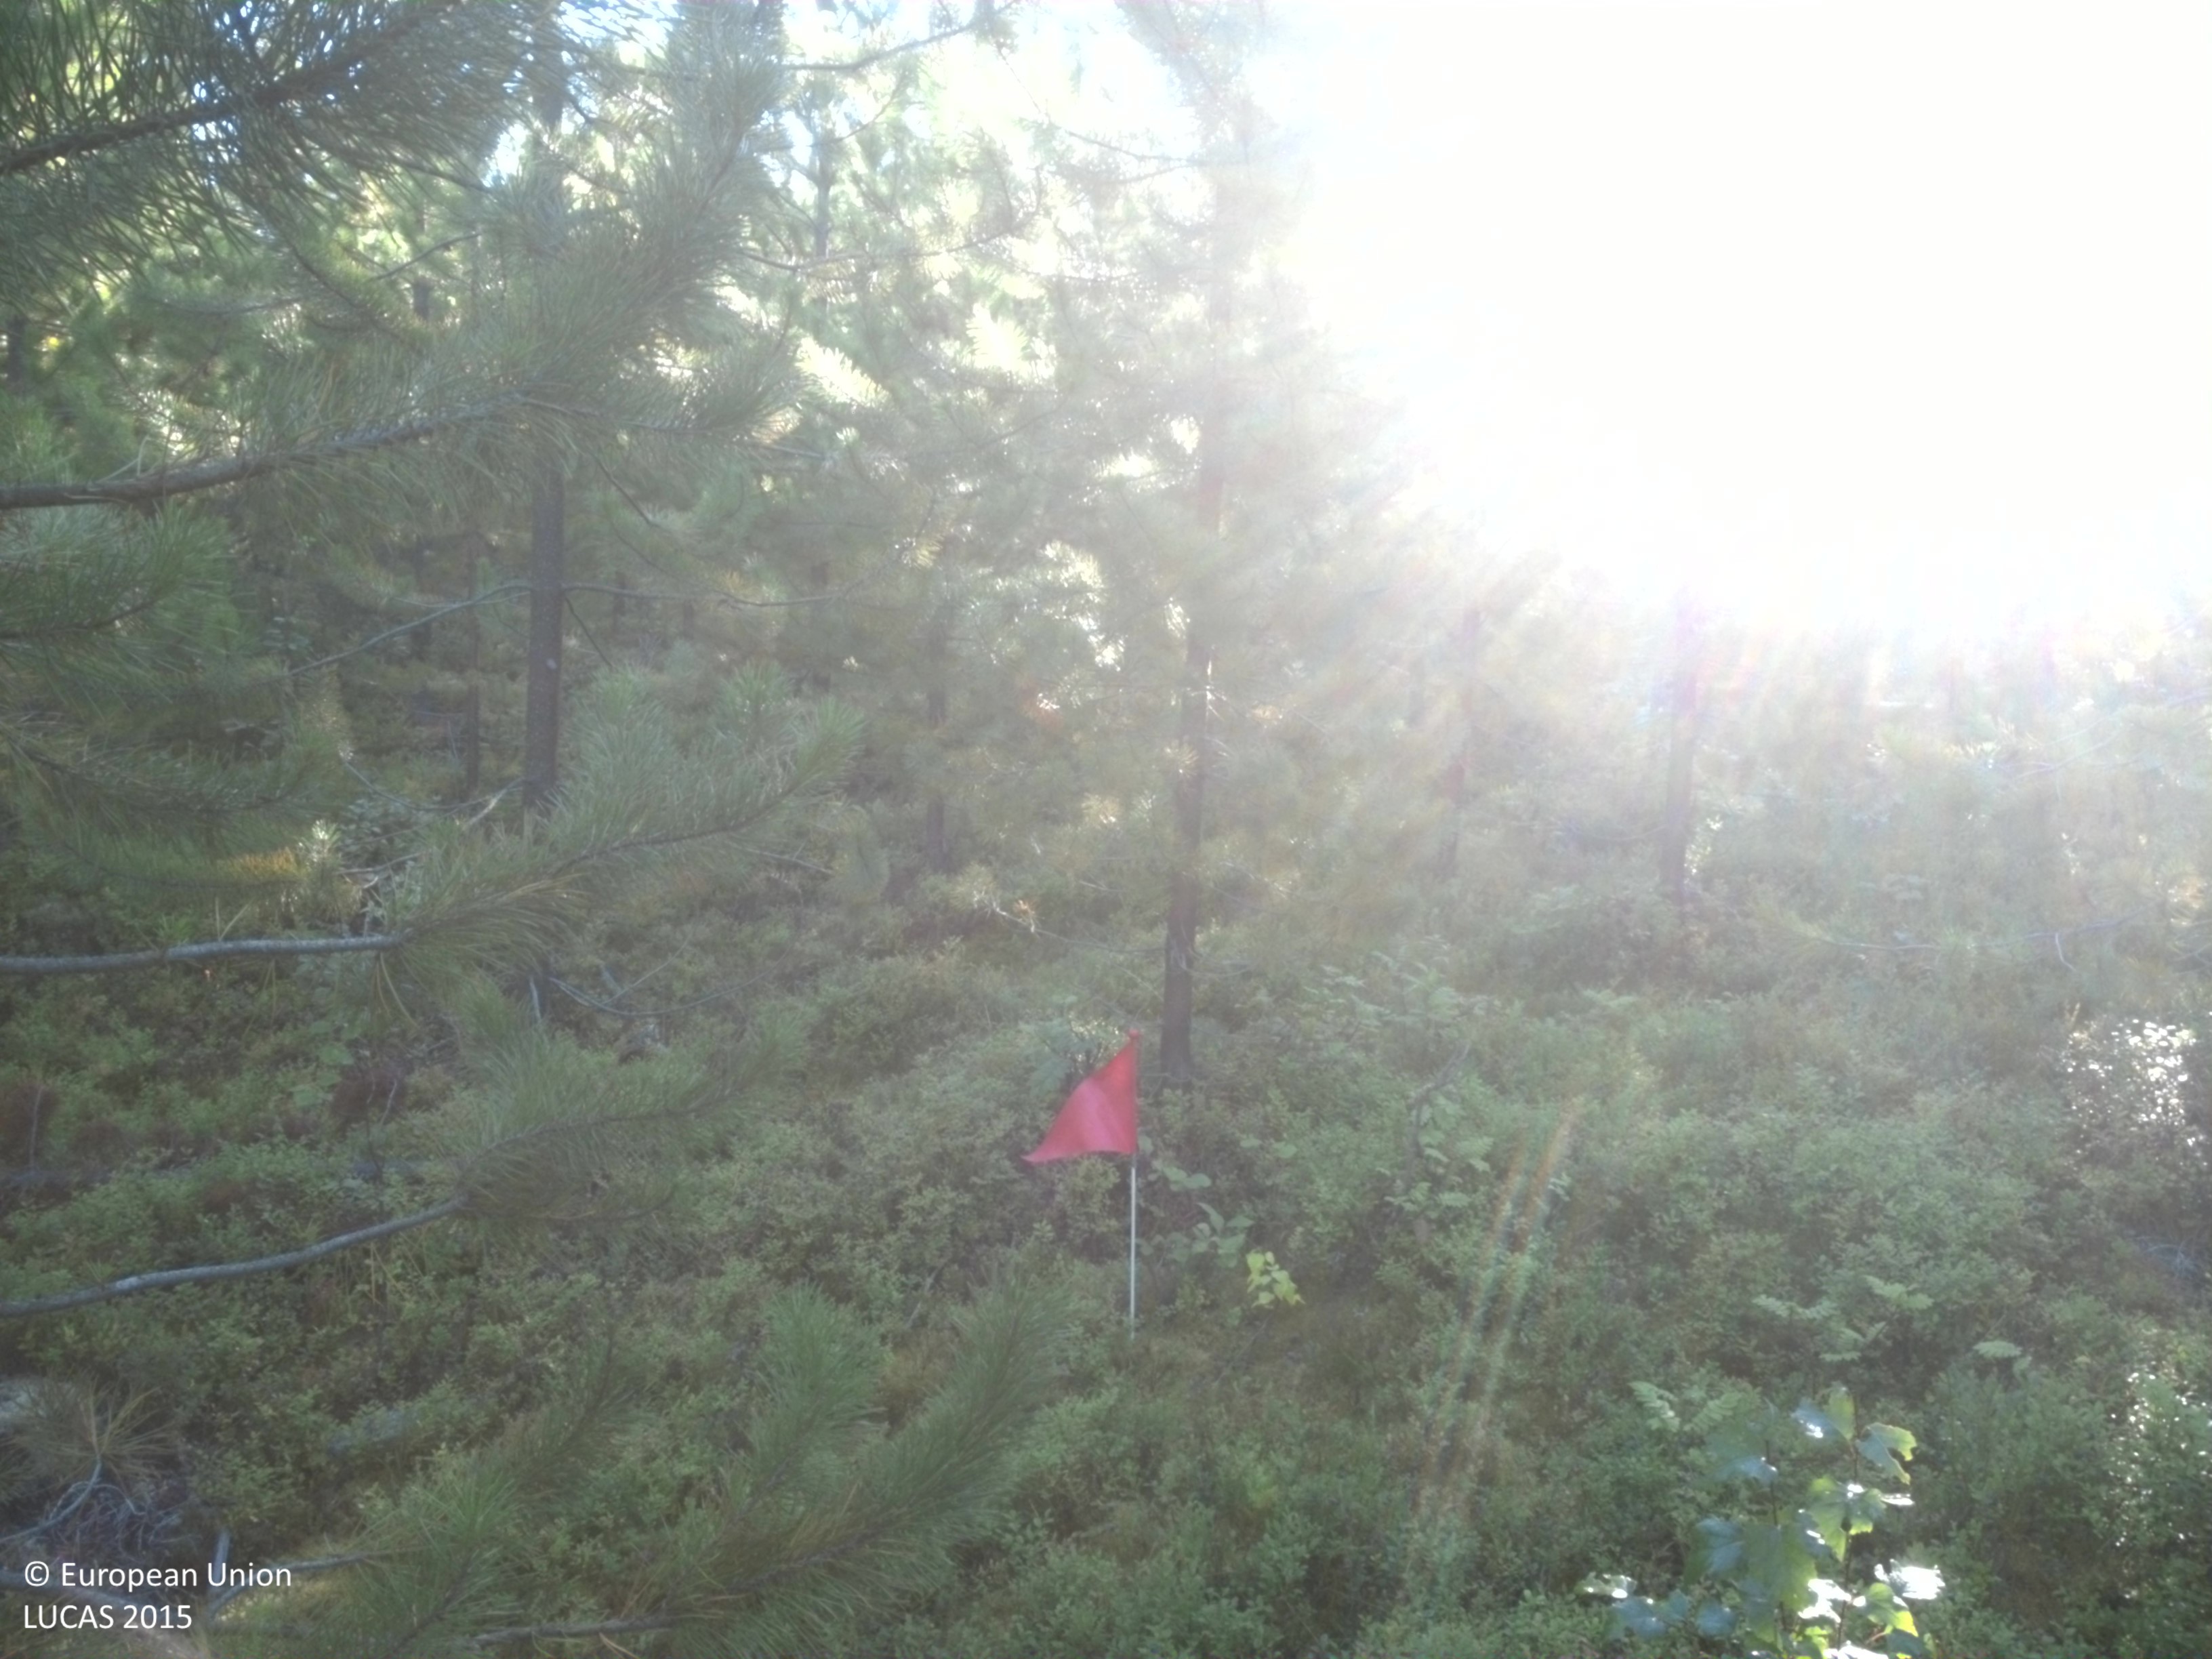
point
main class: Woodland
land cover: Pine dominated coniferous woodland
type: exotic forest
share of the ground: 50 - 75 %
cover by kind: coniferous forest trees 60 %, shrubs 30 %, lichens and mosses 10 %
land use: Forestry
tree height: > 5 m
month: September
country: SE
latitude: 64.5762
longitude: 19.0506
